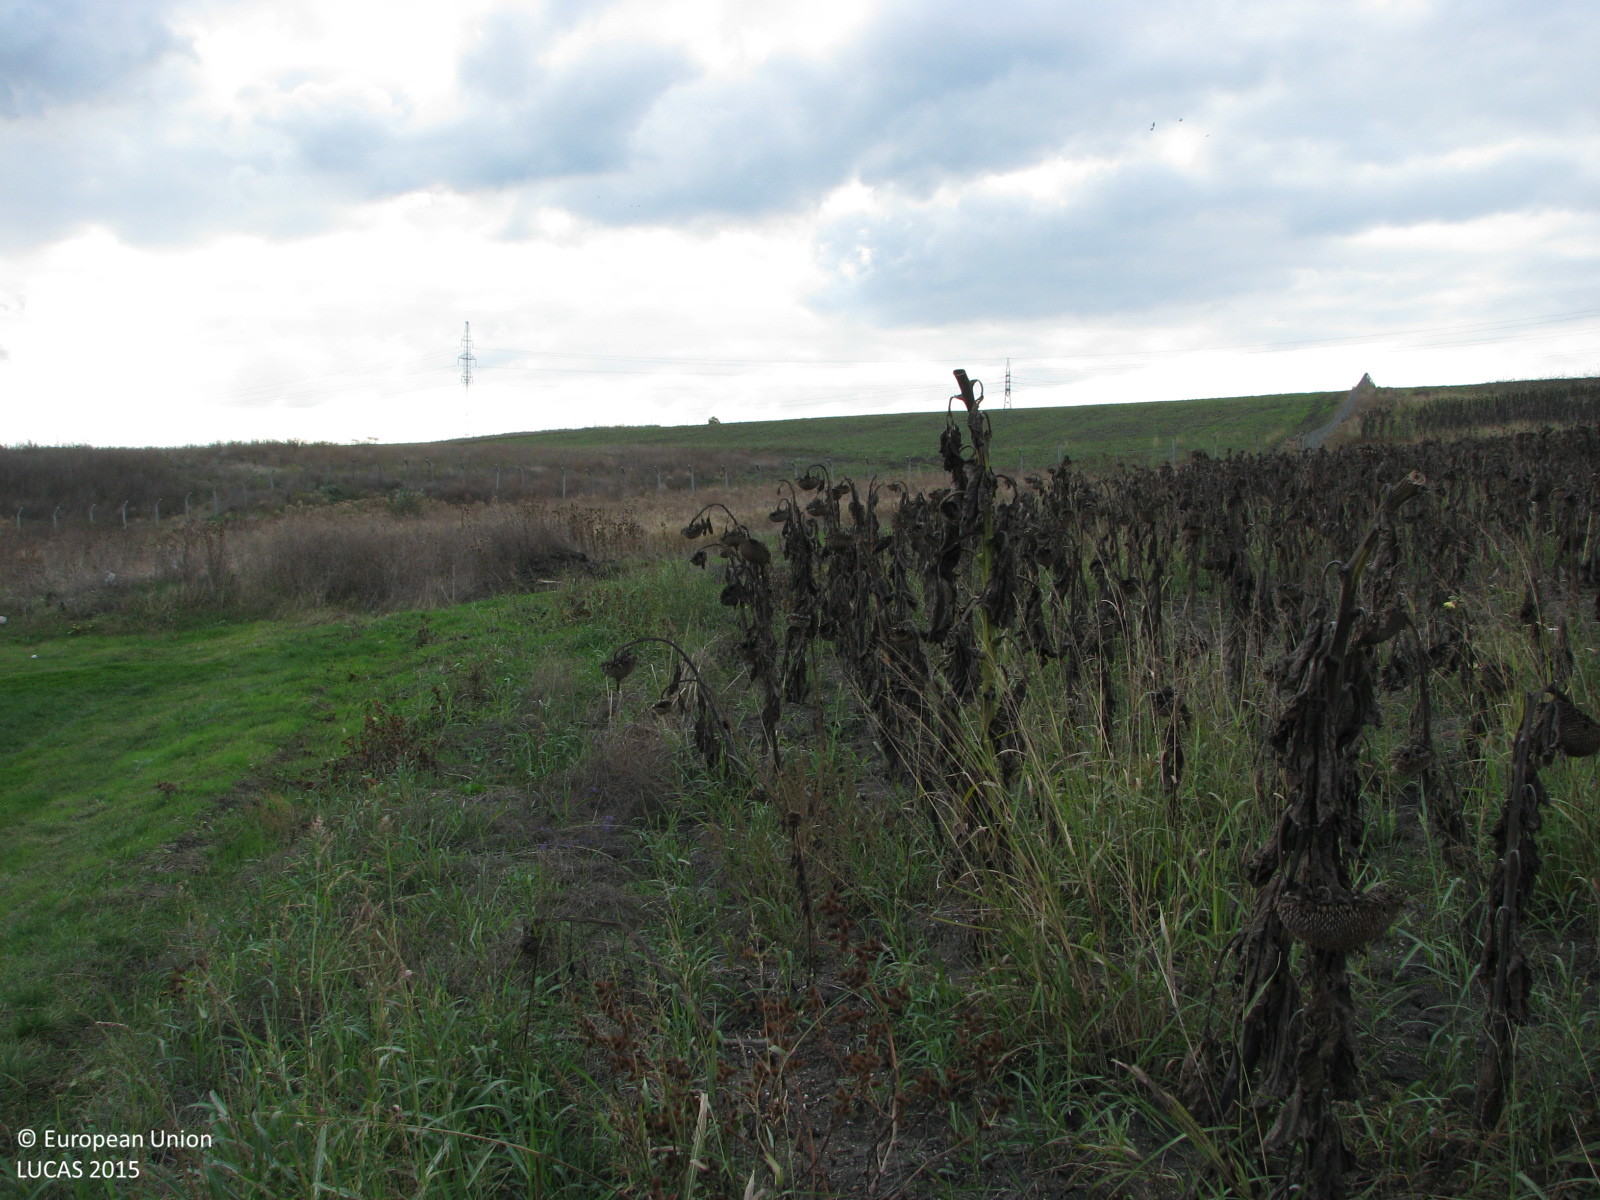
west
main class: Cropland
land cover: Sunflower
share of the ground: 50 - 75 %
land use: Agriculture (excluding fallow land and kitchen gardens)
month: October
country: BG
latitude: 42.2678
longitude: 26.1451
